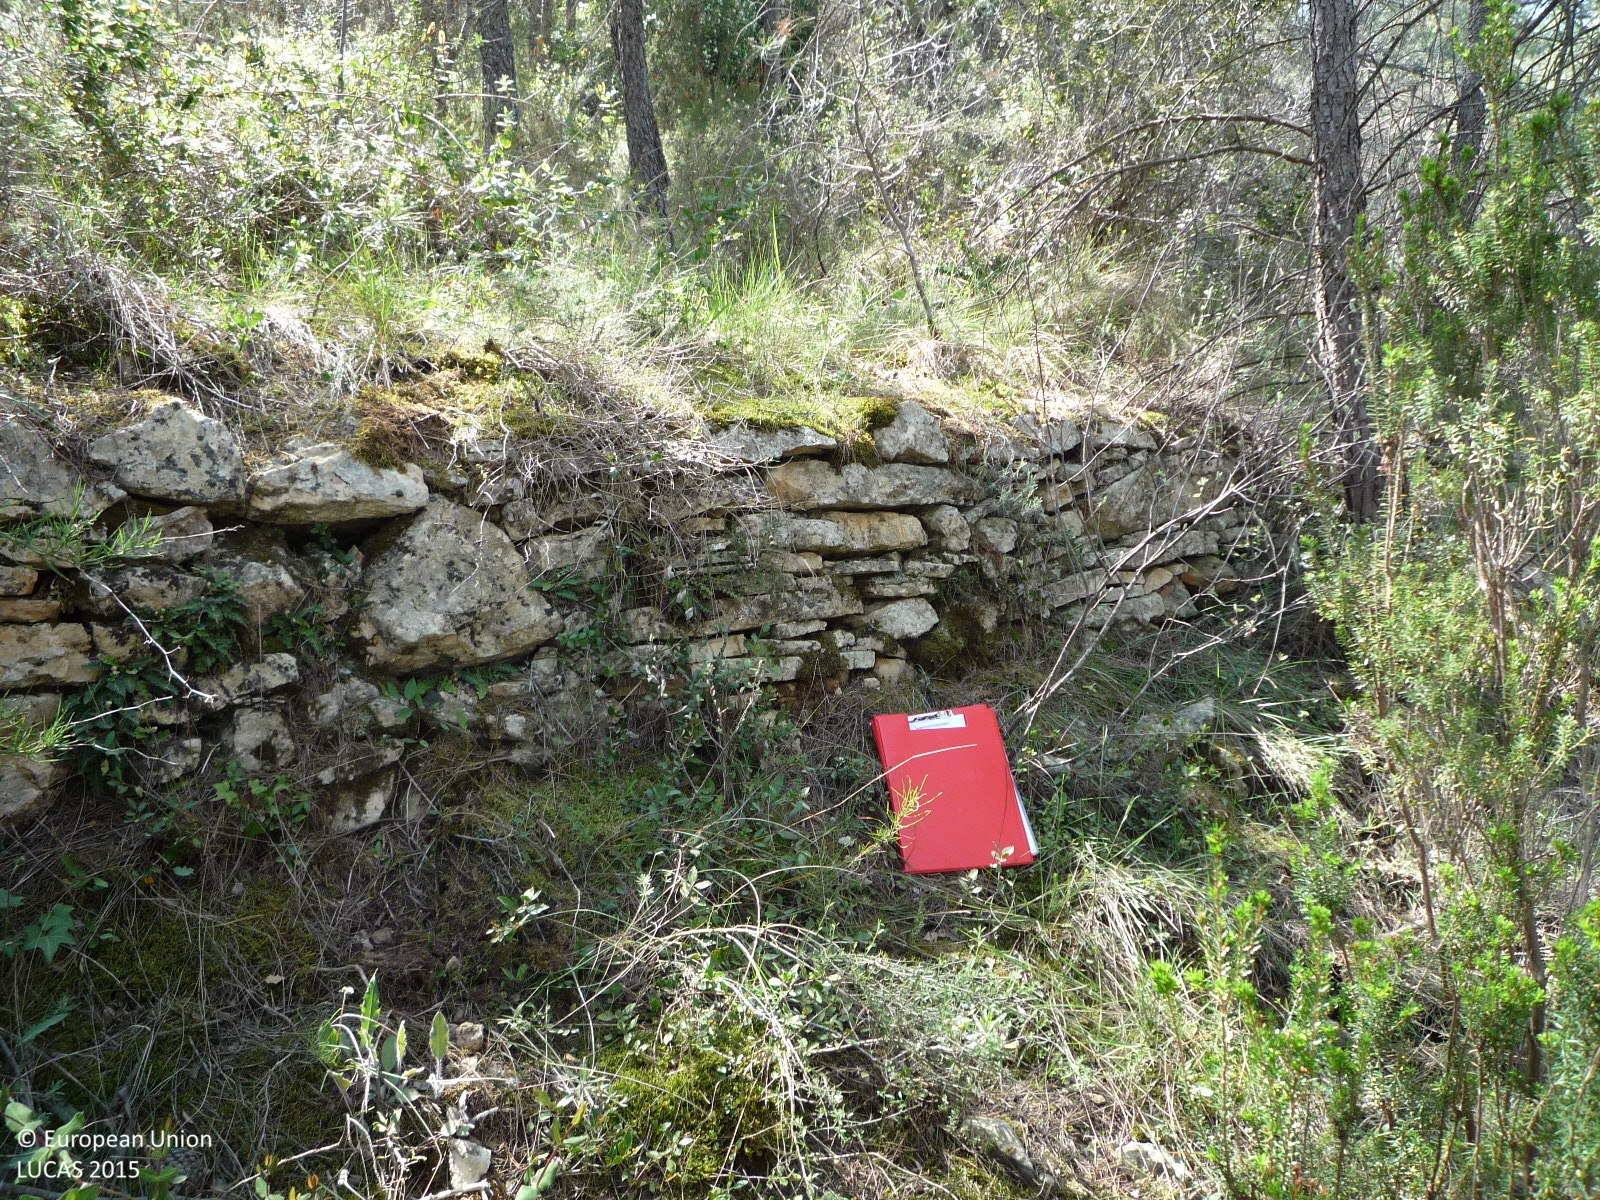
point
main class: Woodland
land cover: Pine dominated coniferous woodland
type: coniferous forest of the mediterranean region
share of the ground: > 75 %
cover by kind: coniferous forest trees 75 %, shrubs 15 %, herbaceous plants 10 %
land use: Semi-natural and natural areas not in use
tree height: > 5 m
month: April
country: ES
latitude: 41.4494
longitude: 1.5774
